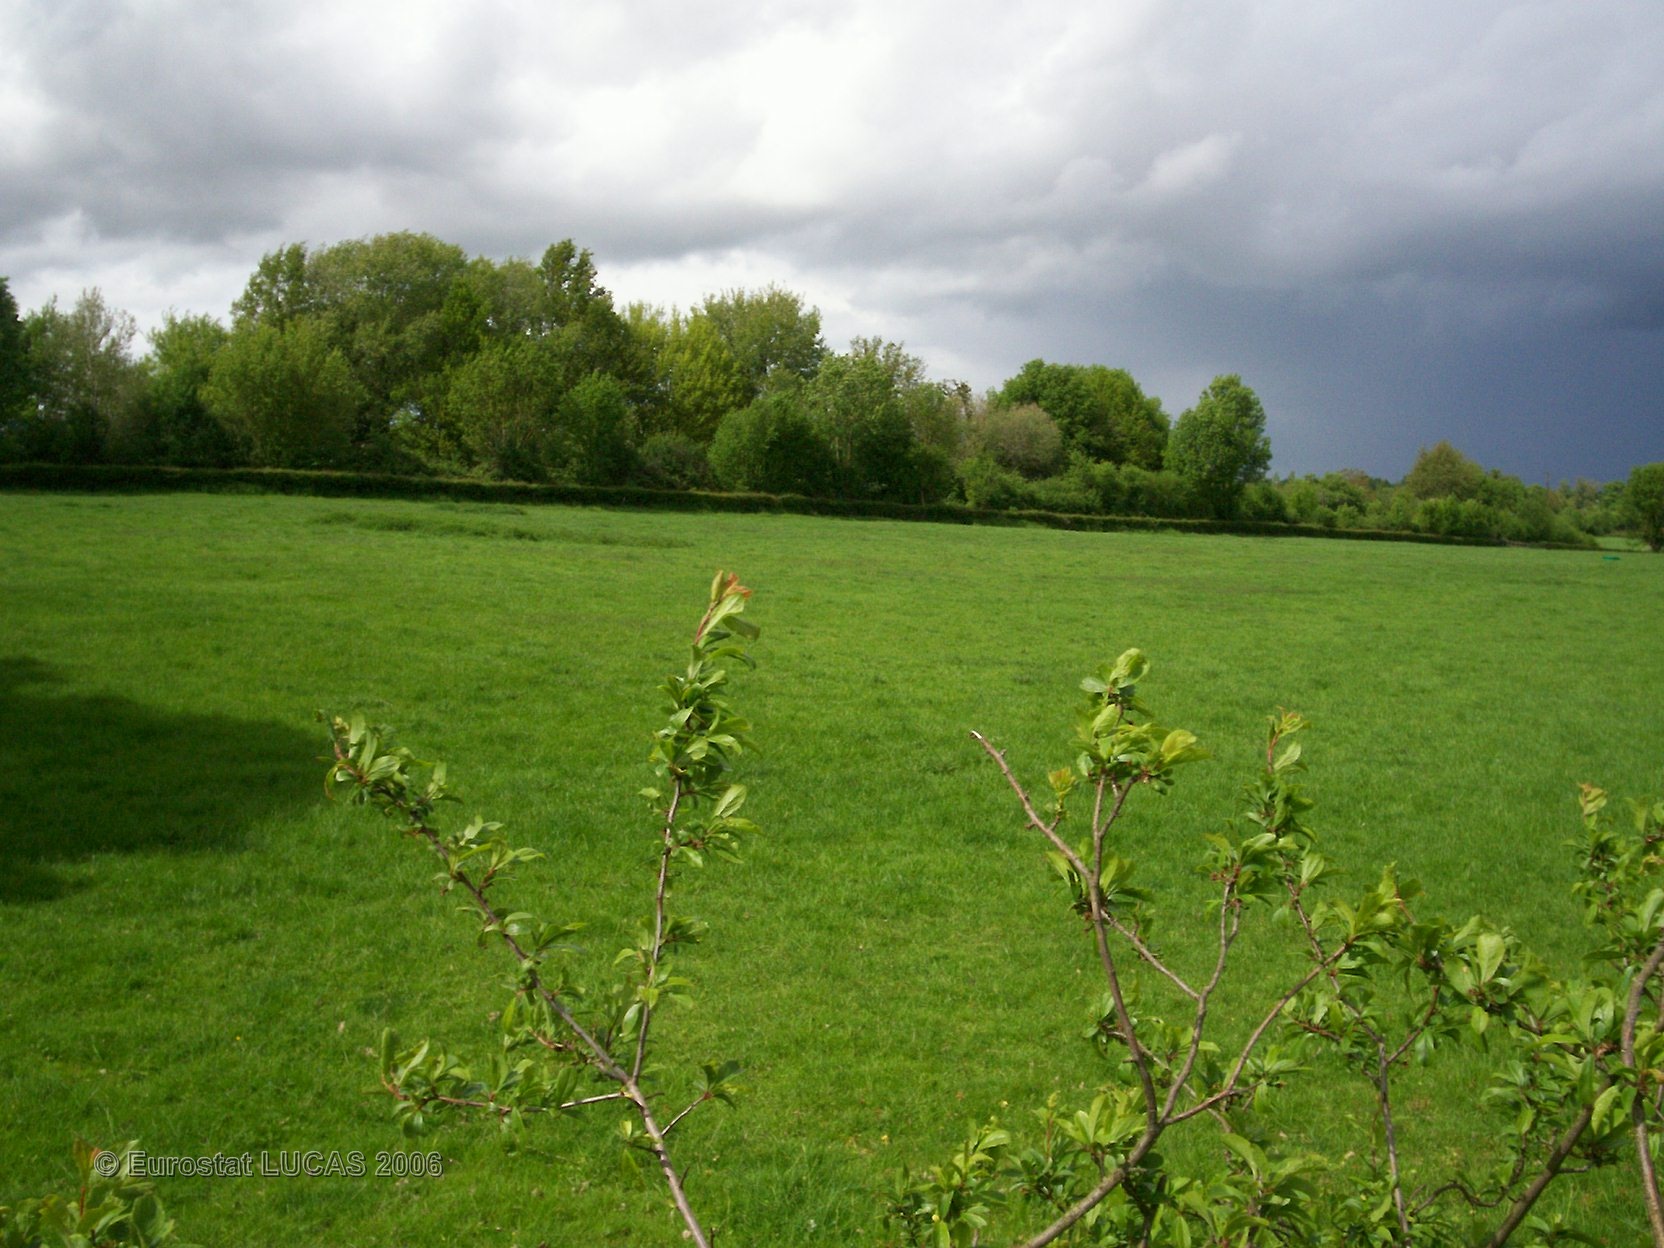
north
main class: Grassland
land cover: Grassland without tree/shrub cover
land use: Agriculture (excluding fallow land and kitchen gardens)
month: May
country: FR
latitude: 46.5995
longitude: -0.2722
